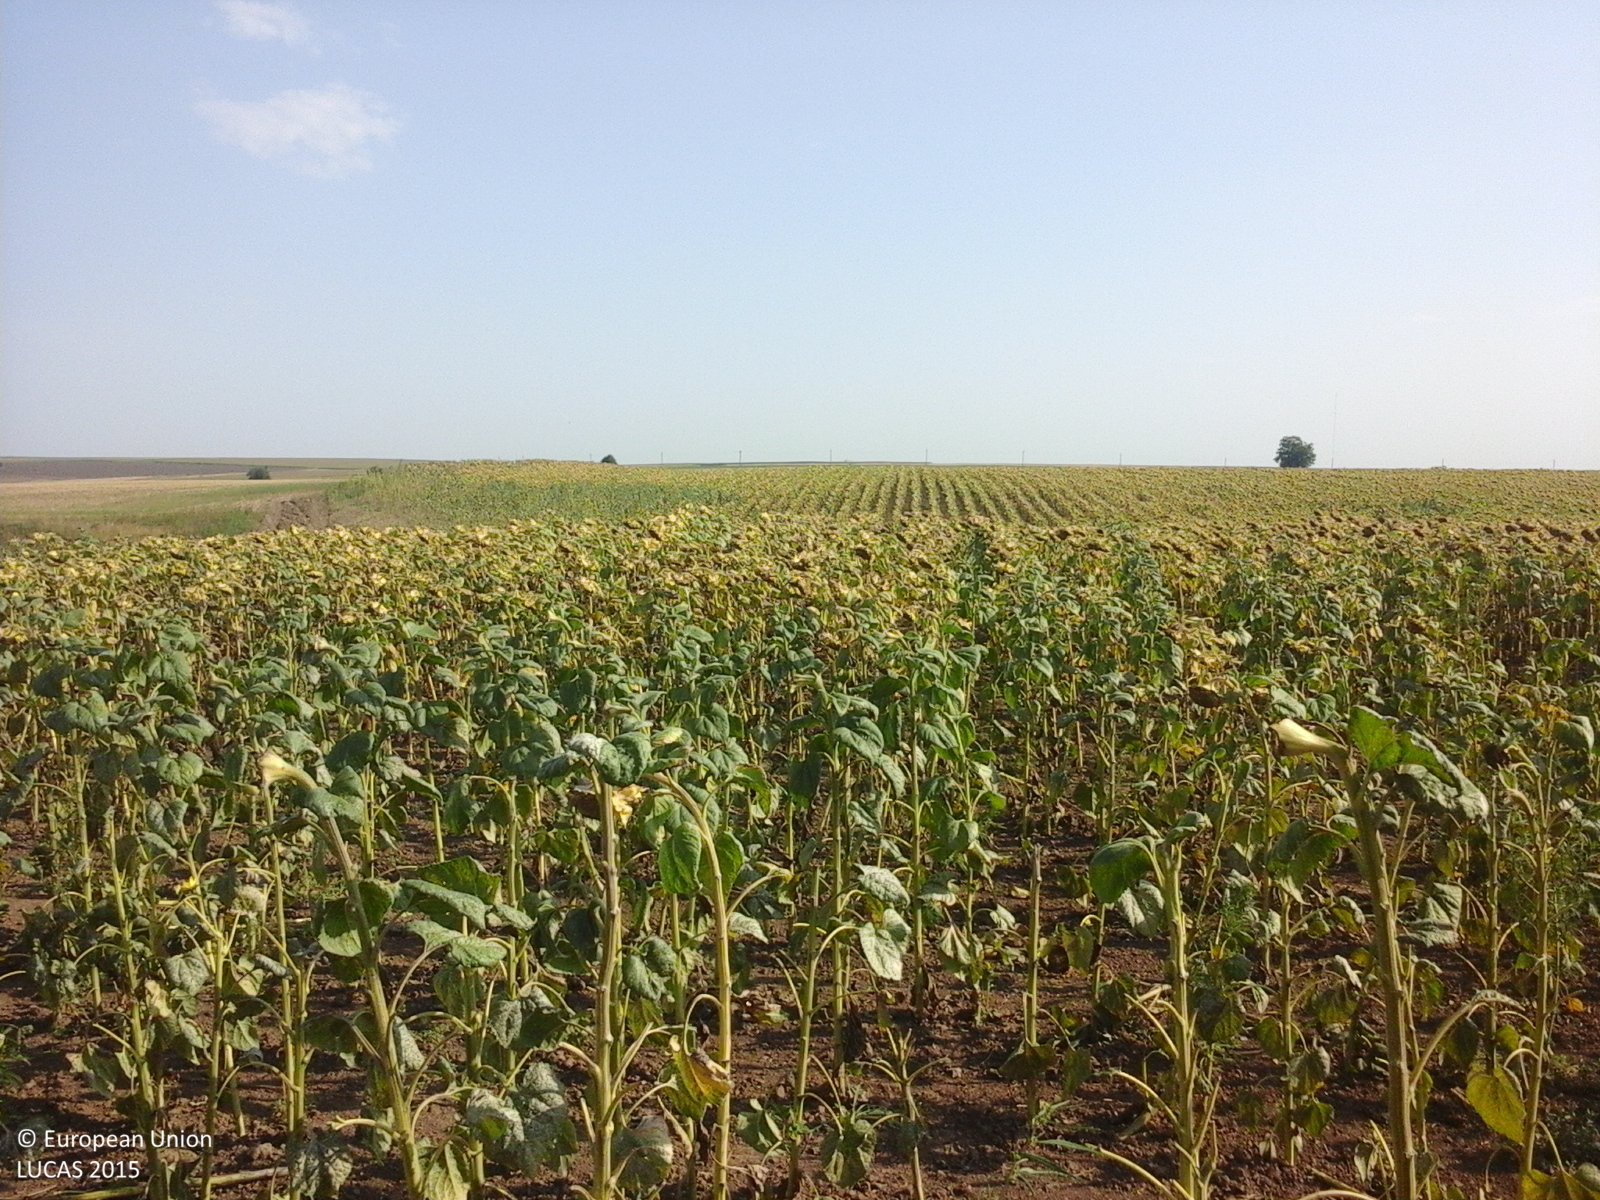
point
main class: Cropland
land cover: Sunflower
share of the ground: > 75 %
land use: Agriculture (excluding fallow land and kitchen gardens)
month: August
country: RO
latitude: 44.0973
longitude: 28.0548
